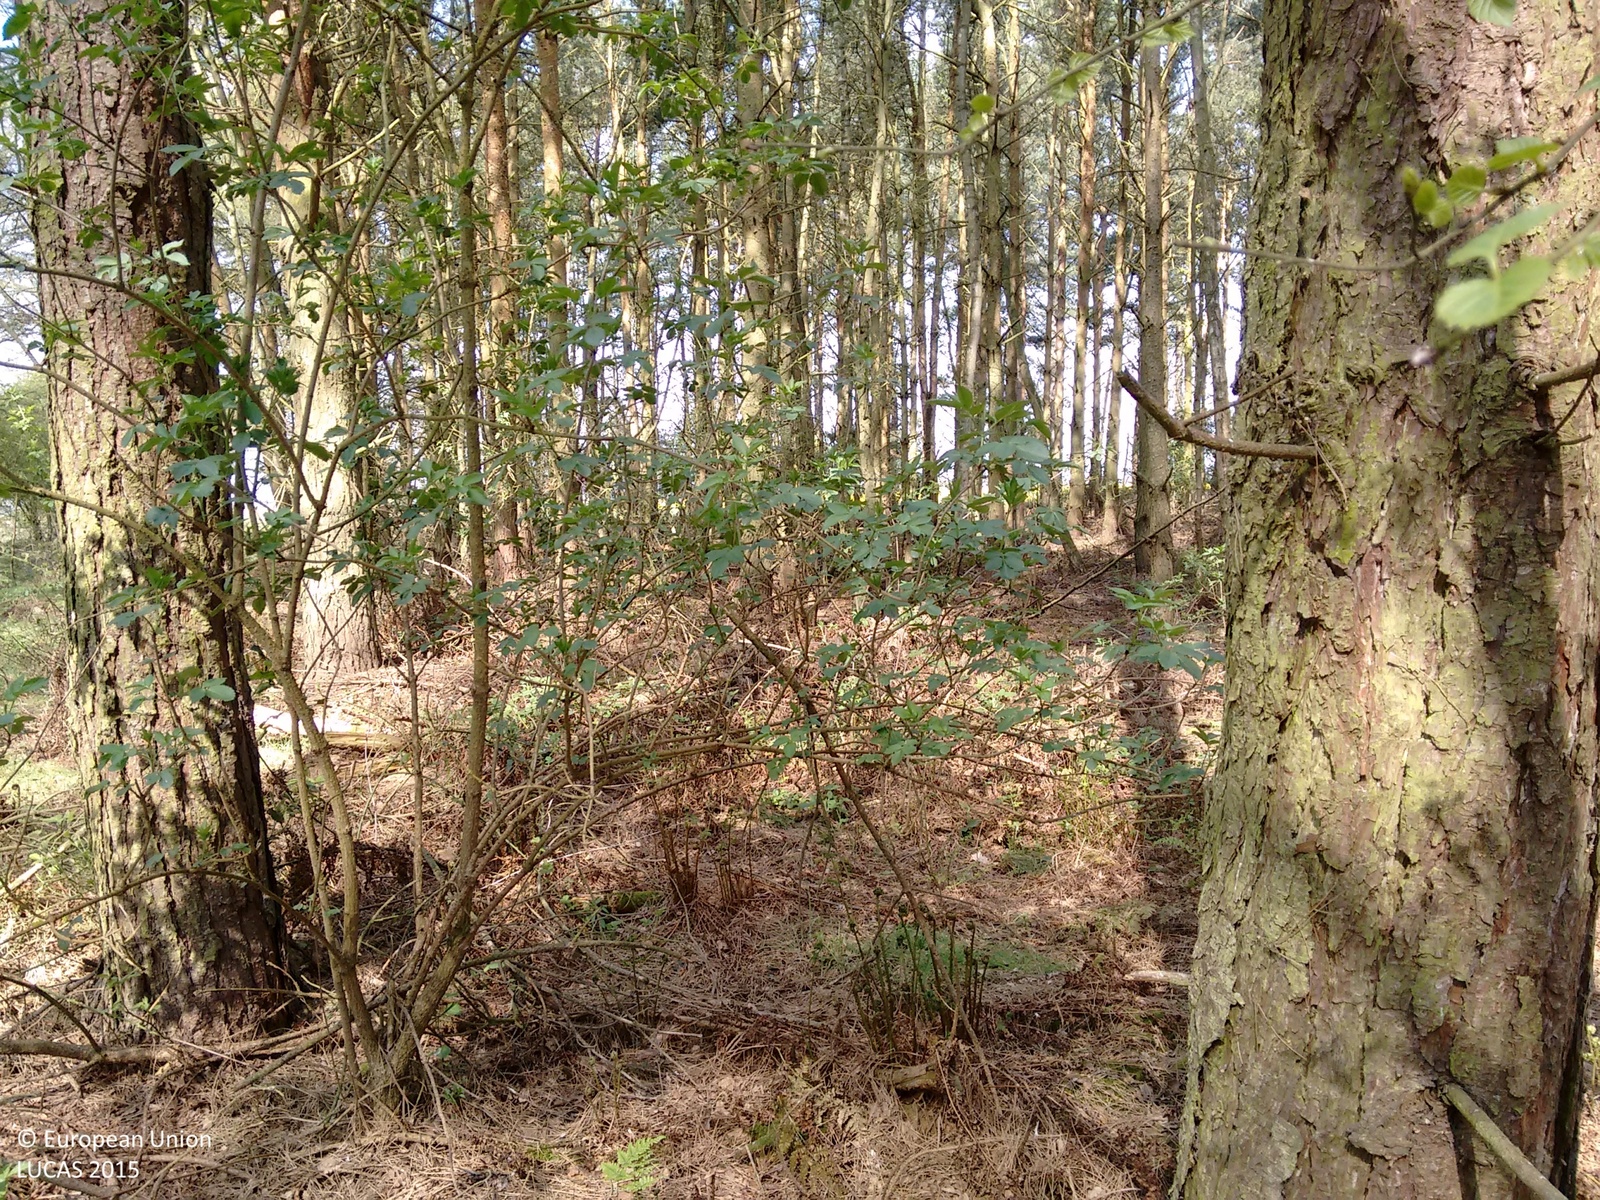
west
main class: Woodland
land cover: Pine dominated coniferous woodland
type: hemiboreal forest and nemoral coniferous forest and mixed broadleaved-coniferous forest
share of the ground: > 75 %
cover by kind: coniferous forest trees 75 %, broadleaved forest trees 25 %
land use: Forestry
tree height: > 5 m
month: April
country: GB
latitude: 53.4662
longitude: -0.7504
